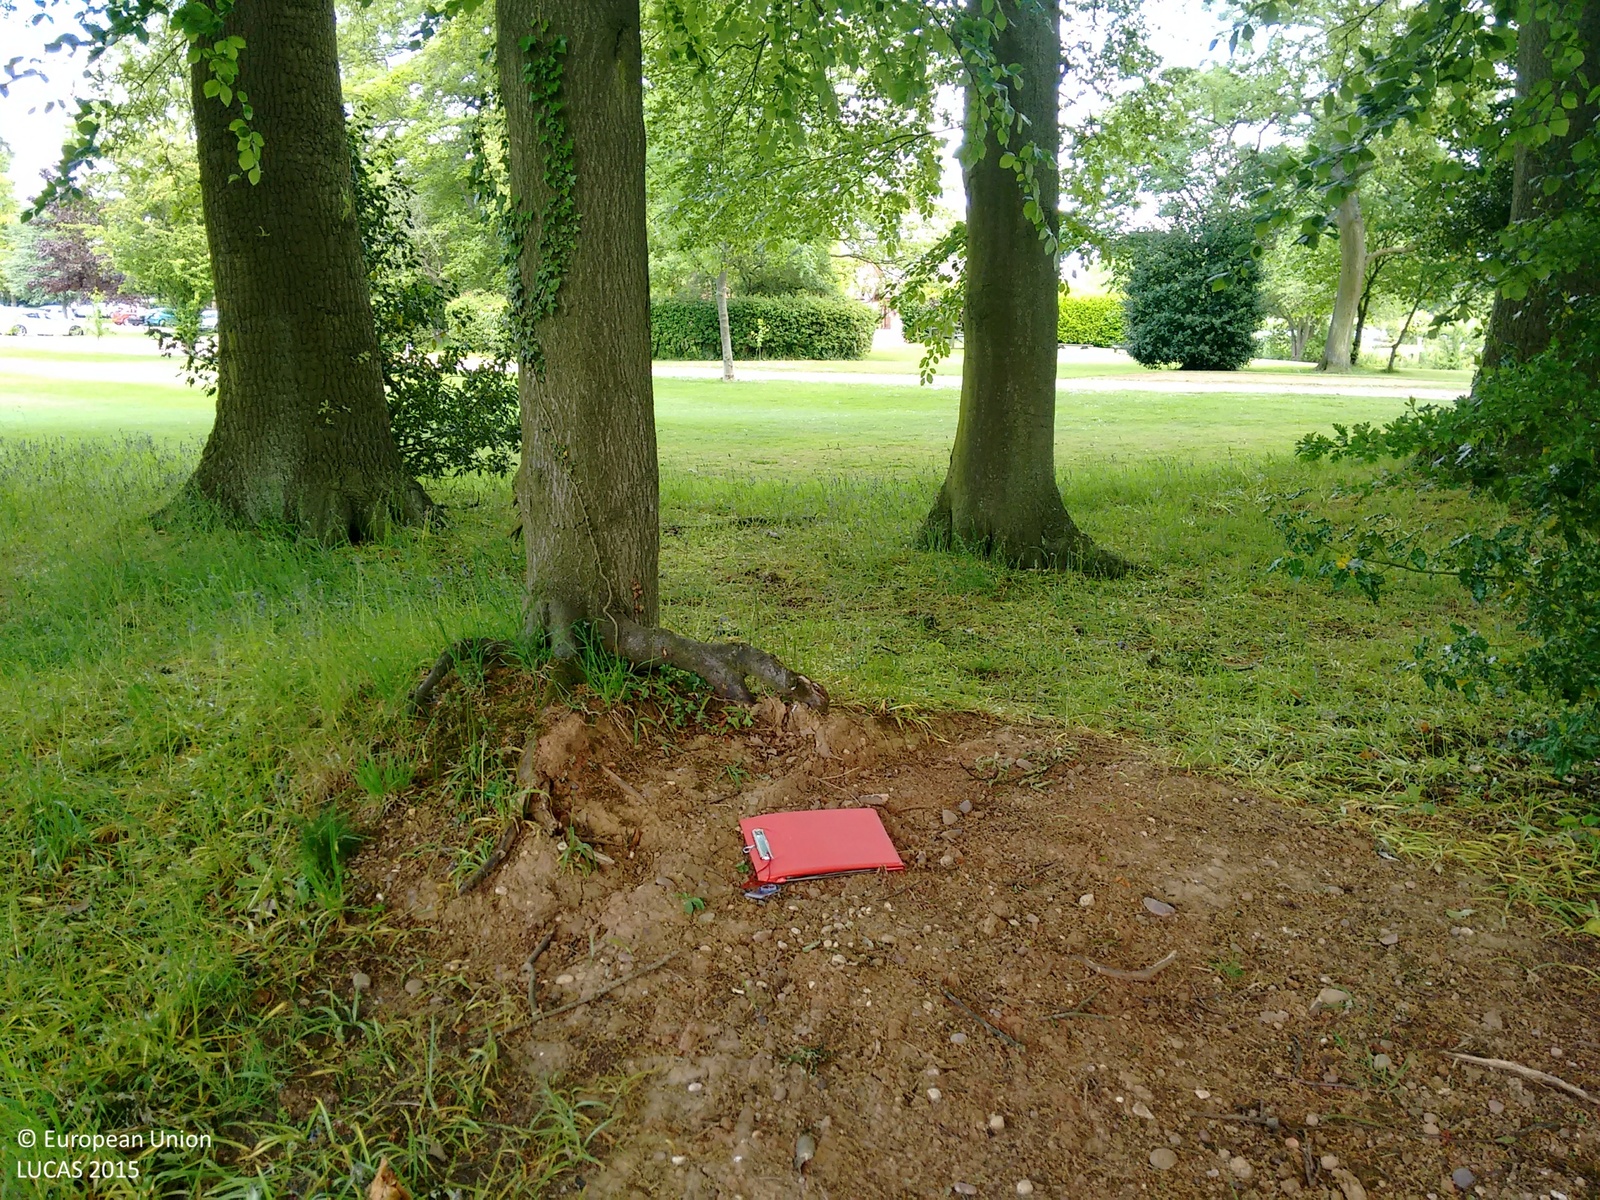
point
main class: Woodland
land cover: Broadleaved woodland
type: mesophytic deciduous forest
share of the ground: > 75 %
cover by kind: broadleaved forest trees 95 %, herbaceous plants 5 %
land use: Sport
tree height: > 5 m
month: June
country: GB
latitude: 52.2864
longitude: -1.7085
